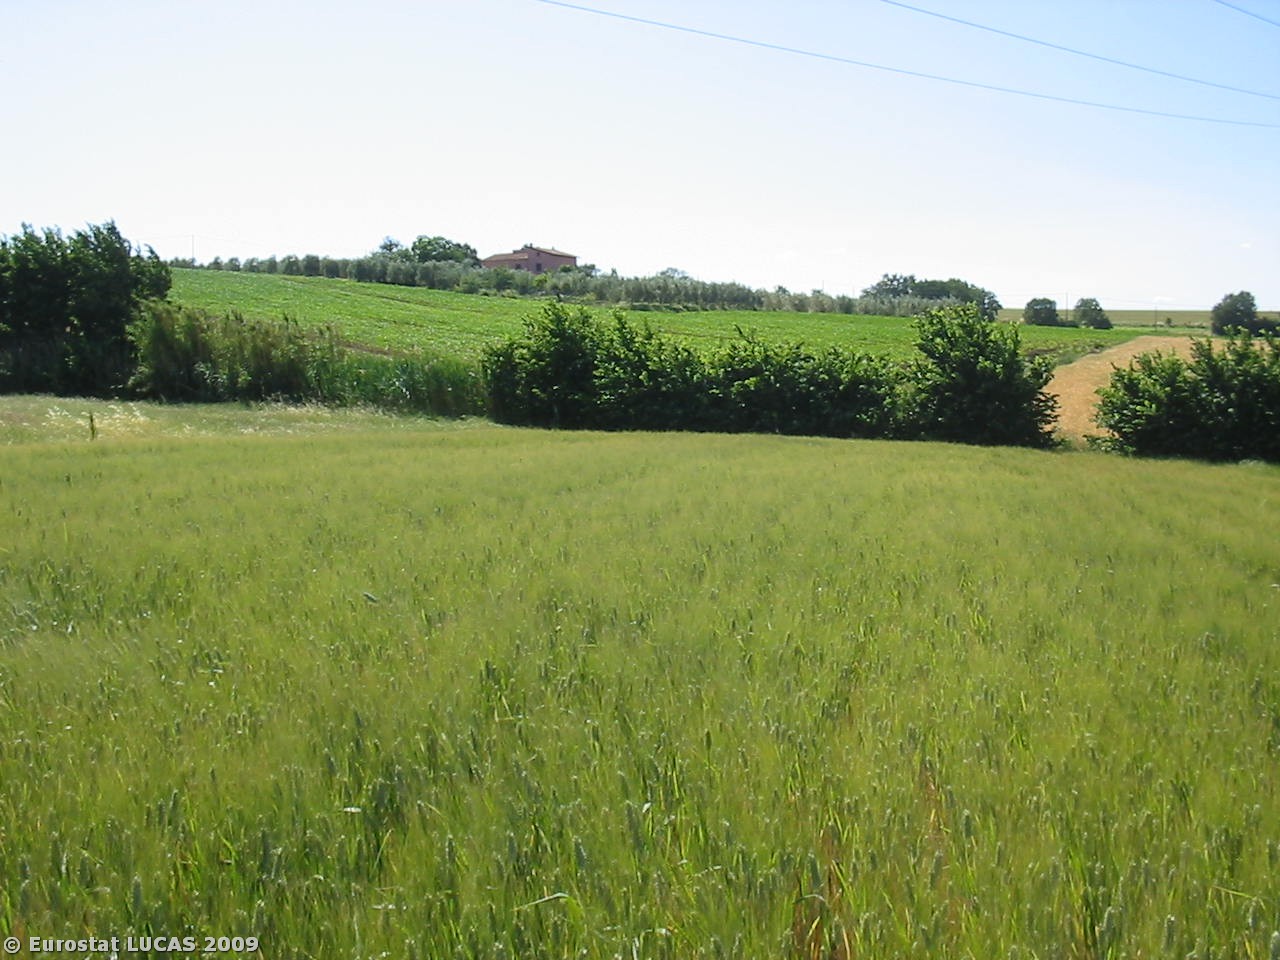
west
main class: Cropland
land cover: Durum wheat
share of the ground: > 75 %
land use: Agriculture (excluding fallow land and kitchen gardens)
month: May
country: IT
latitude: 43.0849
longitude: 12.0453
